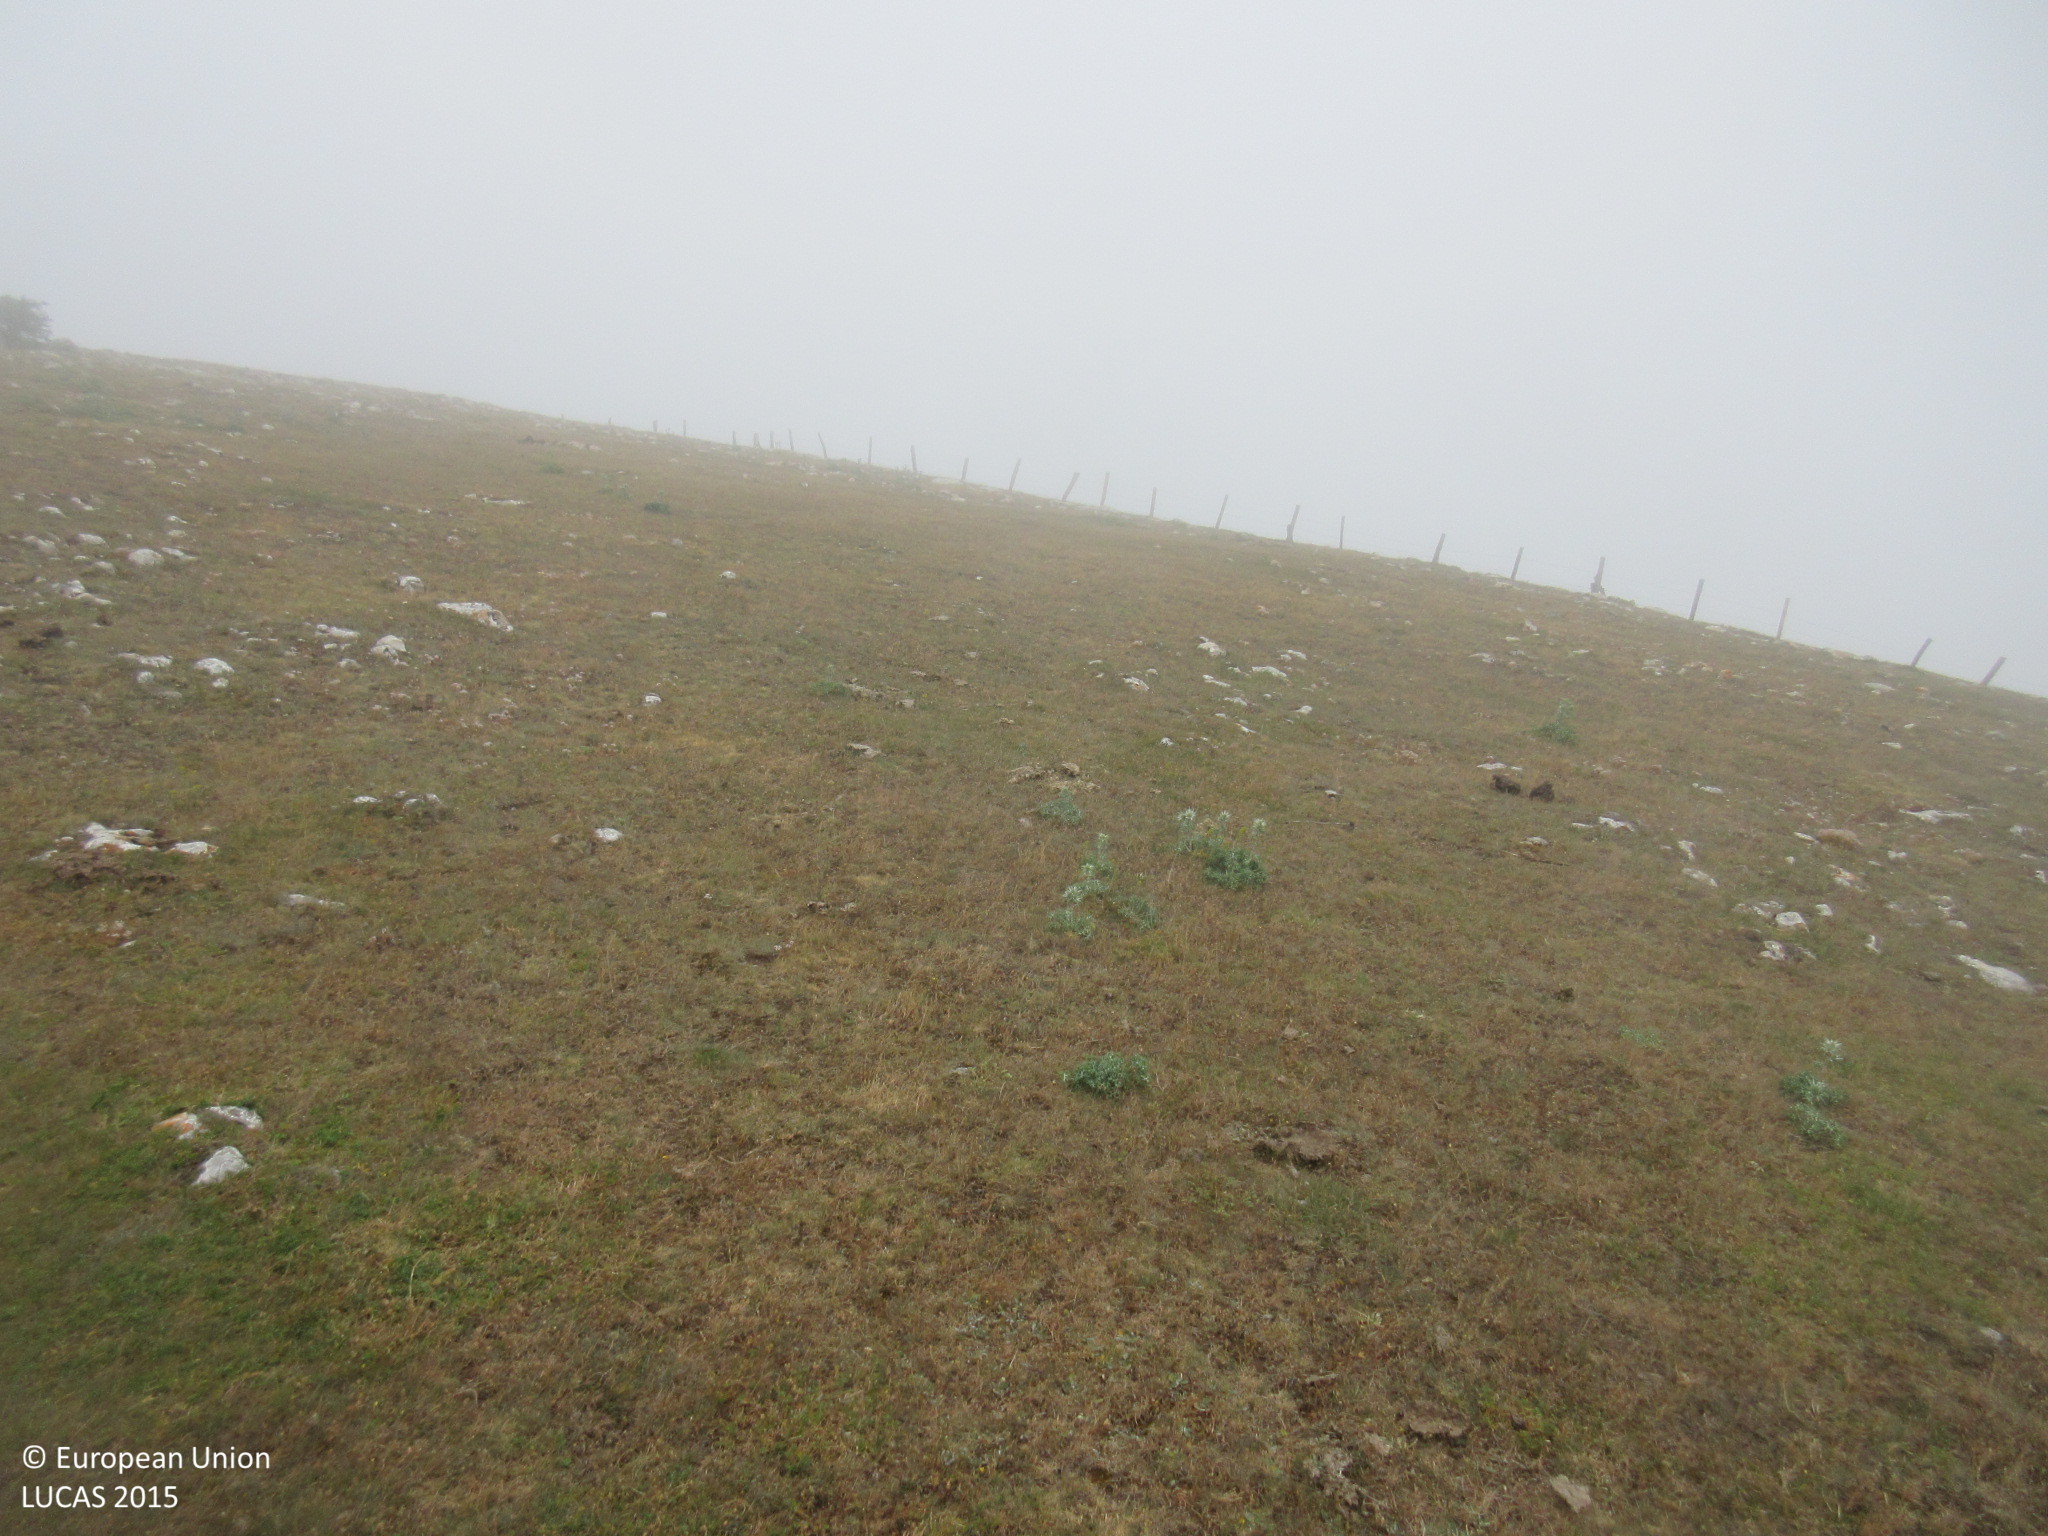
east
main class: Grassland
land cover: Grassland without tree/shrub cover
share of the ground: > 75 %
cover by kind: herbaceous plants 100 %
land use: Agriculture (excluding fallow land and kitchen gardens)
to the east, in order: Grassland without tree/shrub cover; Fences; Rocks and stones; Grassland without tree/shrub cover; Single bushes/trees; Grassland without tree/shrub cover
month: July
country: ES
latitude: 43.0266
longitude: -4.0264
